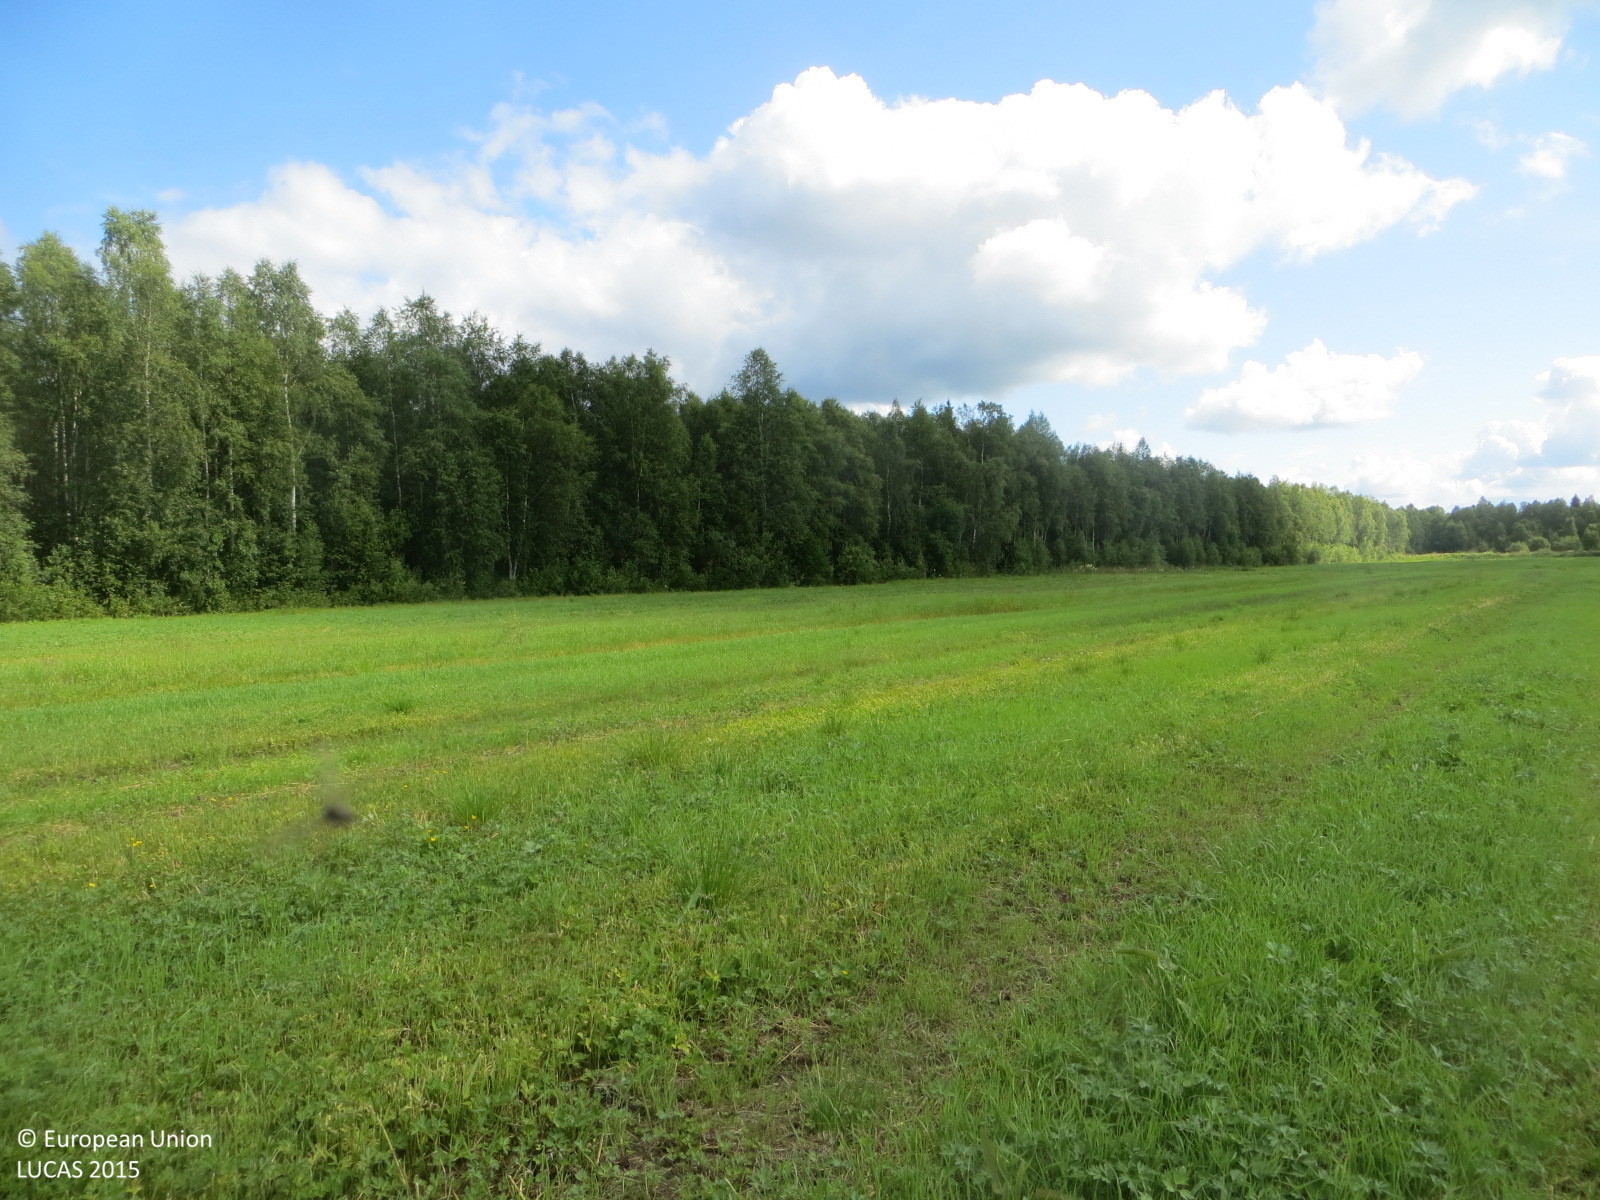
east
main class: Grassland
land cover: Spontaneously vegetated surfaces
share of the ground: > 75 %
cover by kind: herbaceous plants 100 %
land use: Fallow land
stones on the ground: < 10 %
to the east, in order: Spontaneously vegetated surfaces; Ditches and canals; Broadleaved woodland; Ditches and canals; Spruce dominated mixed woodland; Ditches and canals; Spruce dominated mixed woodland; Ditches and canals; Broadleaved woodland; Ditches and canals; Grassland without tree/shrub cover; Ditches and canals; Grassland without tree/shrub cover
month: July
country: FI
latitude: 65.8861
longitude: 24.2850
